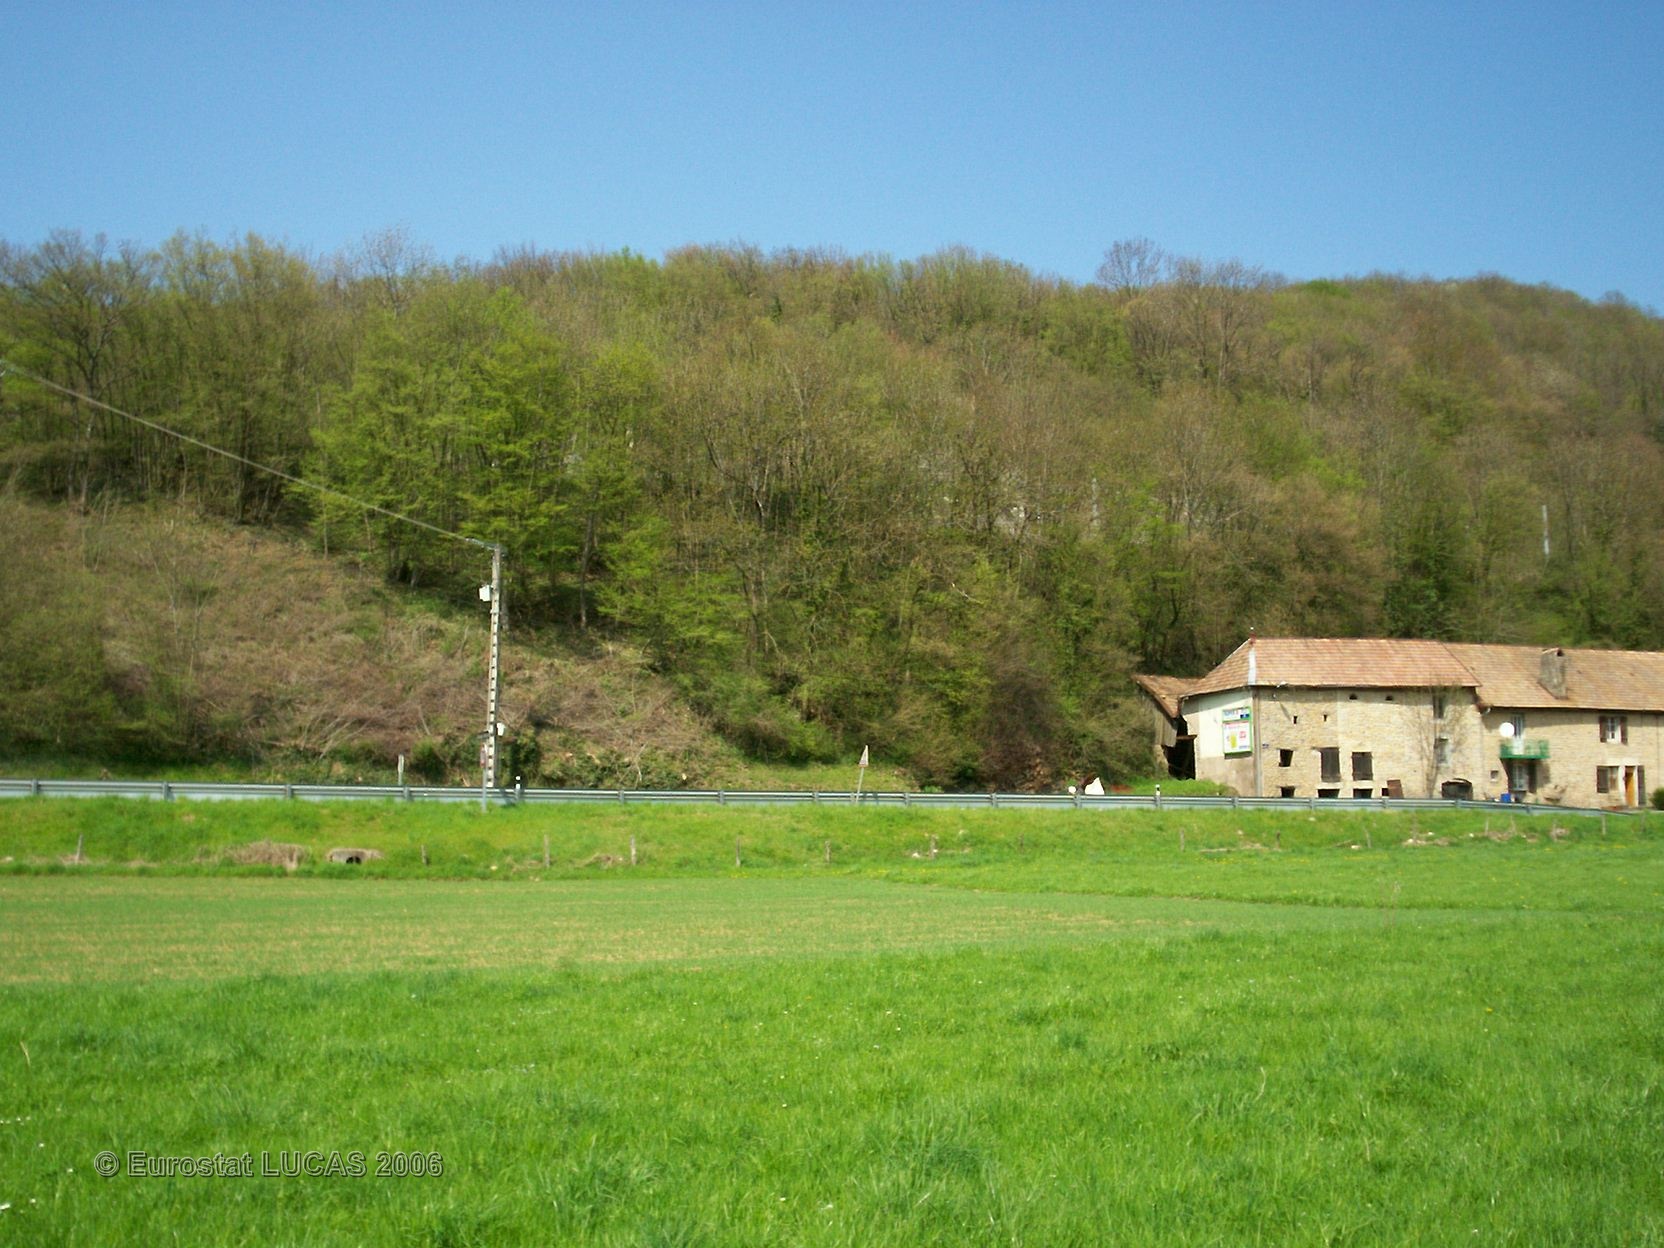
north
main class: Grassland
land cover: Grassland without tree/shrub cover
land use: Agriculture (excluding fallow land and kitchen gardens)
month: April
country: FR
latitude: 47.3537
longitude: 6.3876
